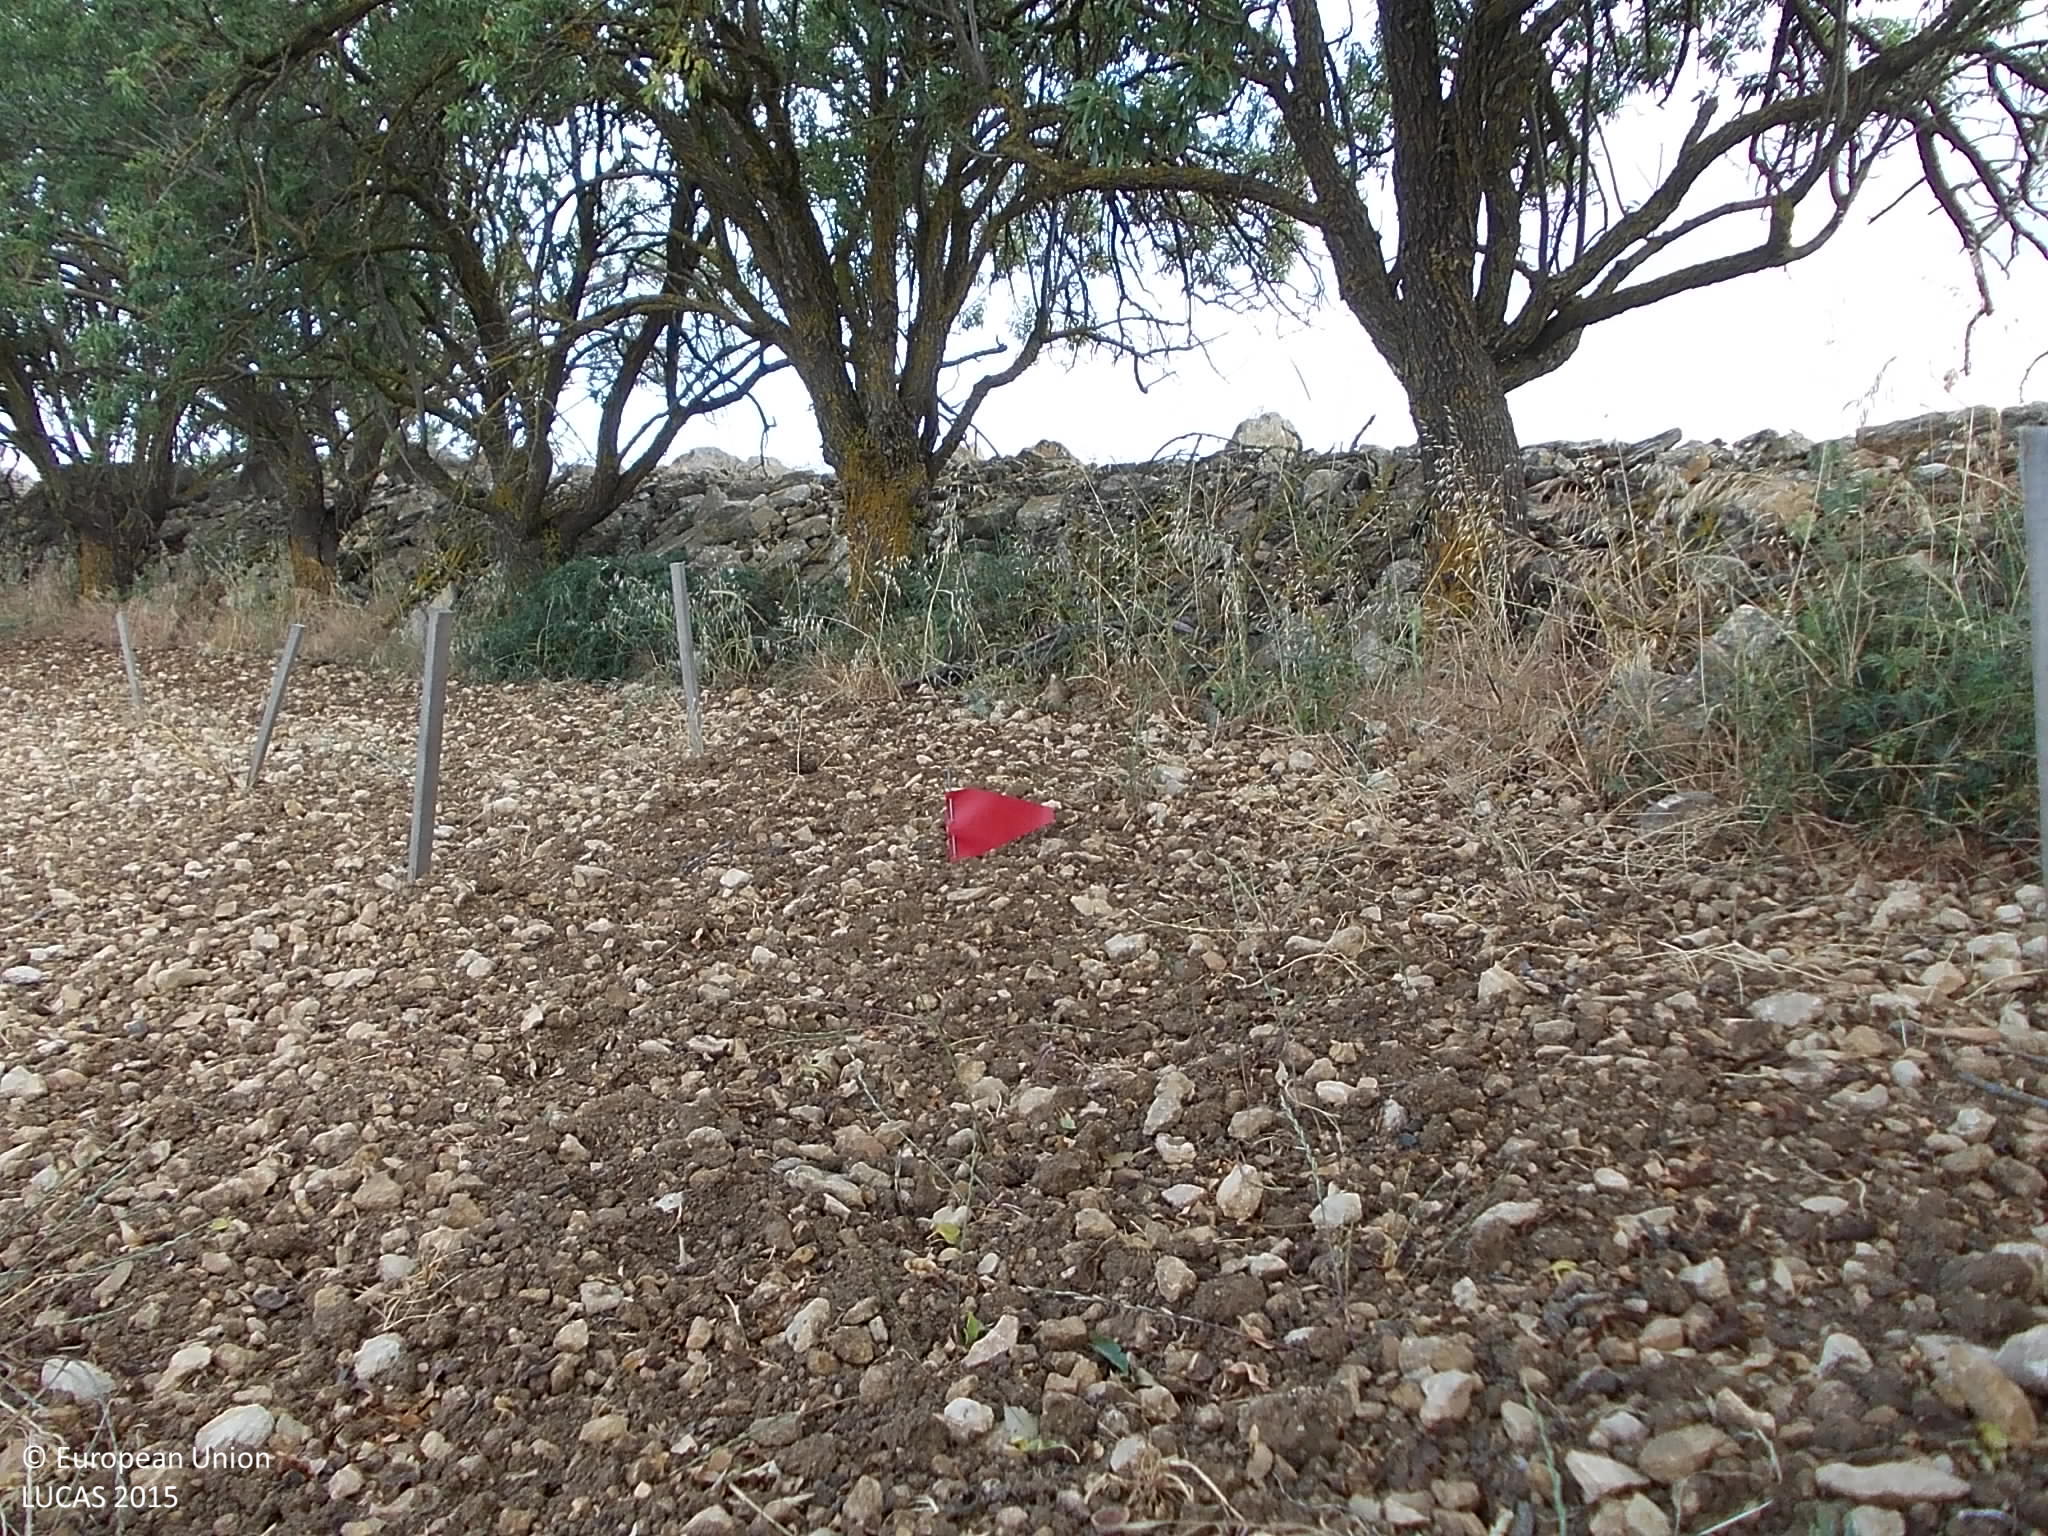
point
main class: Cropland
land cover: Vineyards
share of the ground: < 10 %
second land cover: Nuts trees
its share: < 10 %
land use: Agriculture (excluding fallow land and kitchen gardens)
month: May
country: CY
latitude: 34.7731
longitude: 32.7873
